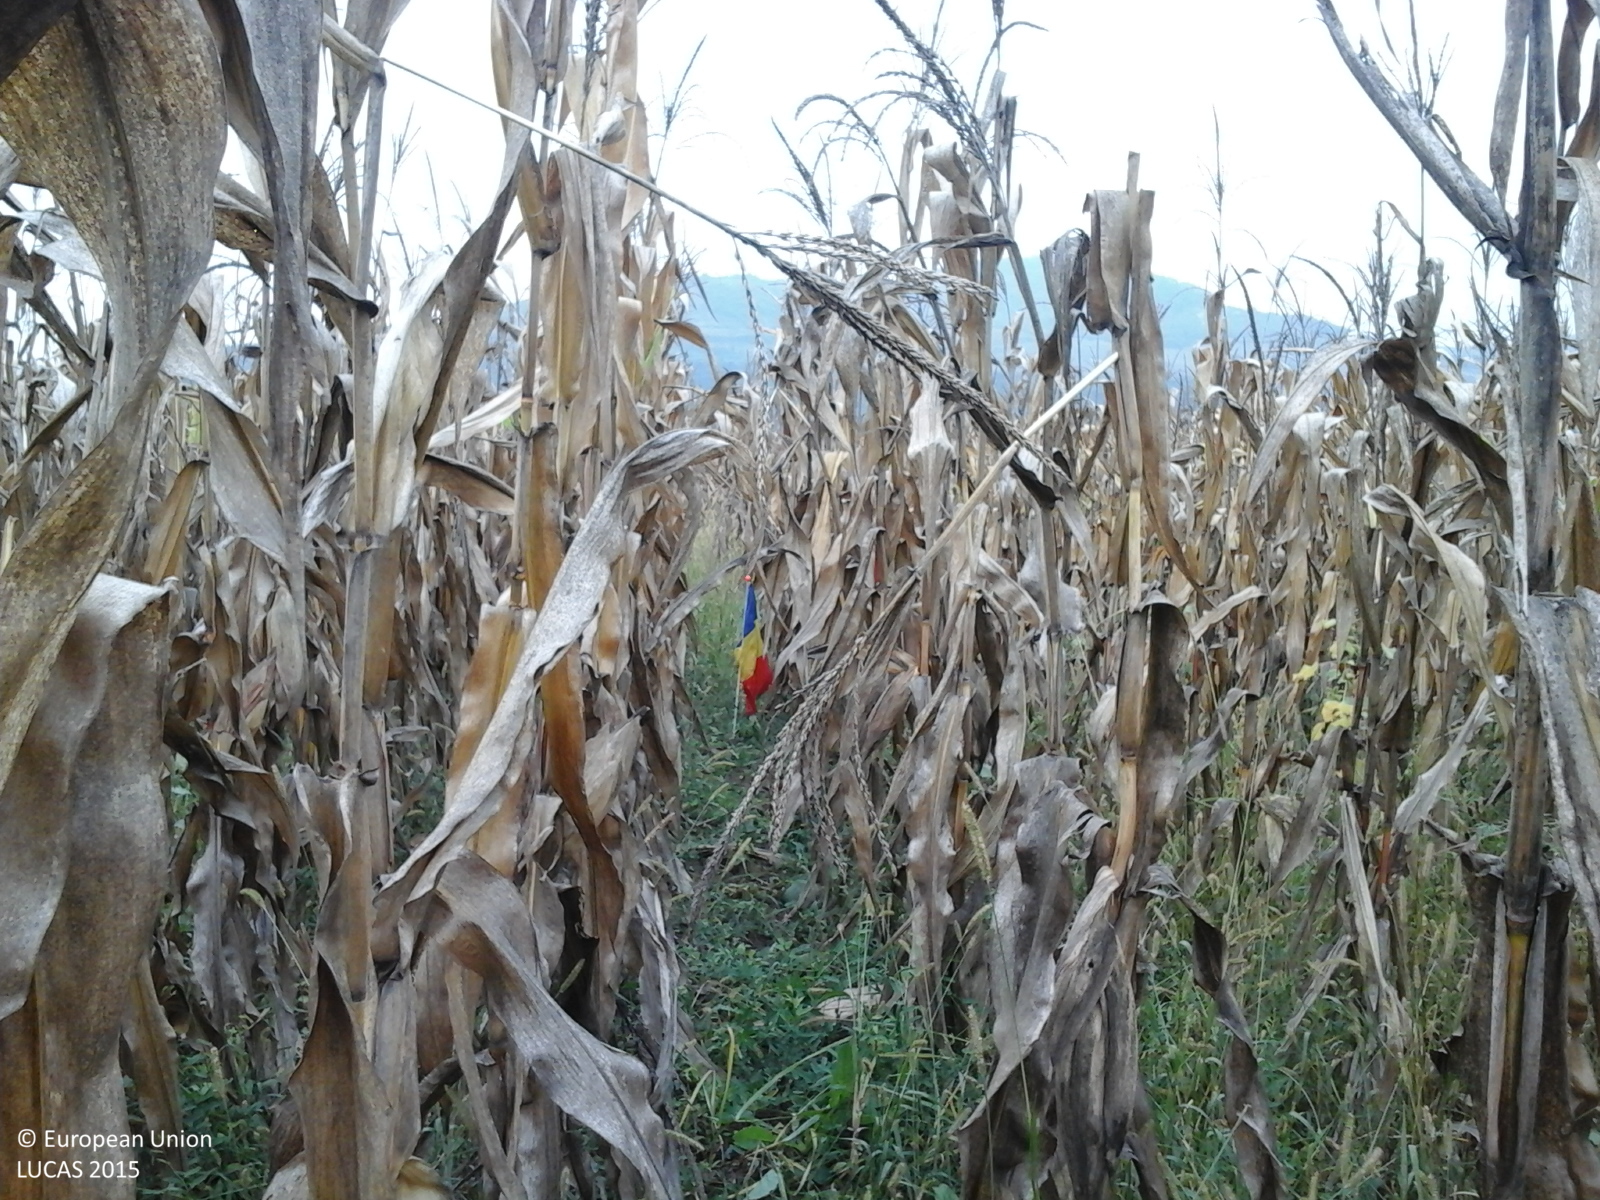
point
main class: Cropland
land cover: Maize
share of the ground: > 75 %
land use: Agriculture (excluding fallow land and kitchen gardens)
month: September
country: RO
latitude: 45.9179
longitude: 22.8565
